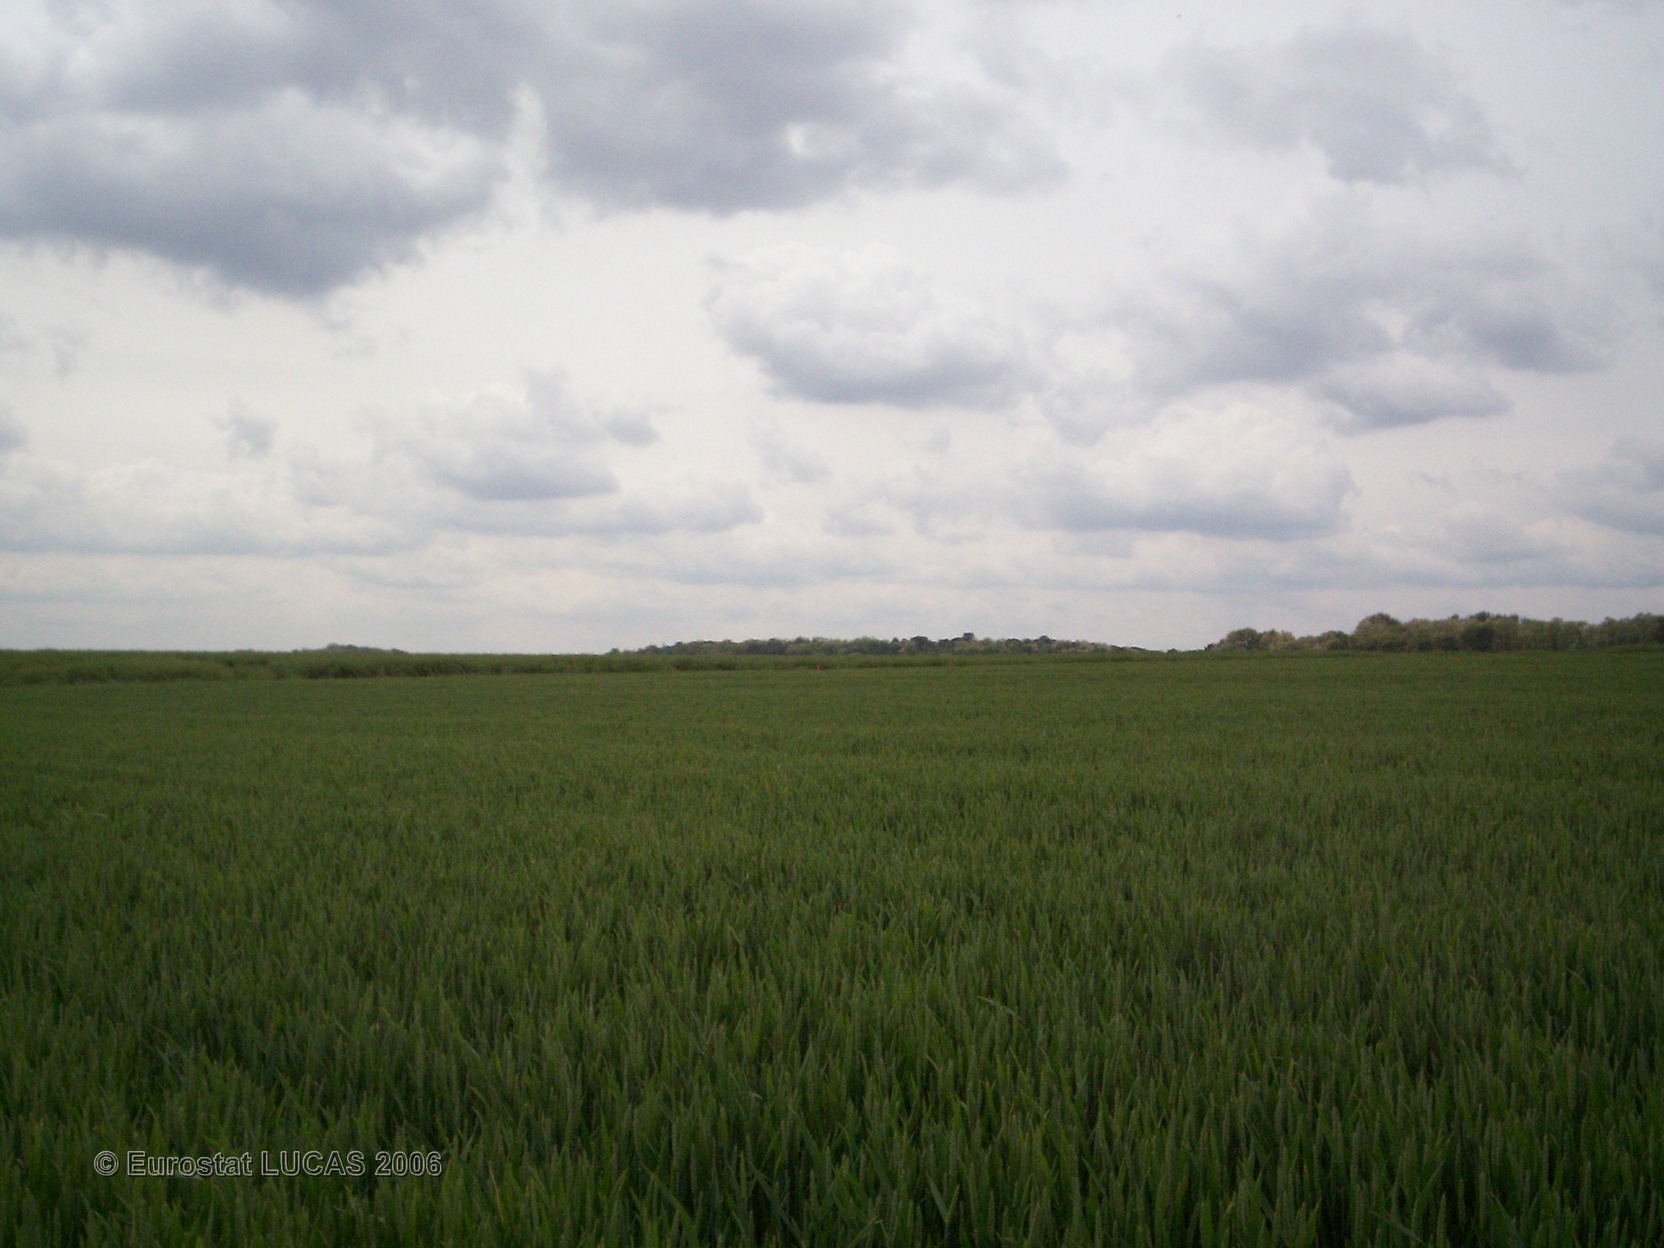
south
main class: Cropland
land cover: Common wheat
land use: Agriculture (excluding fallow land and kitchen gardens)
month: June
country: FR
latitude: 49.3743
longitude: 2.7312
